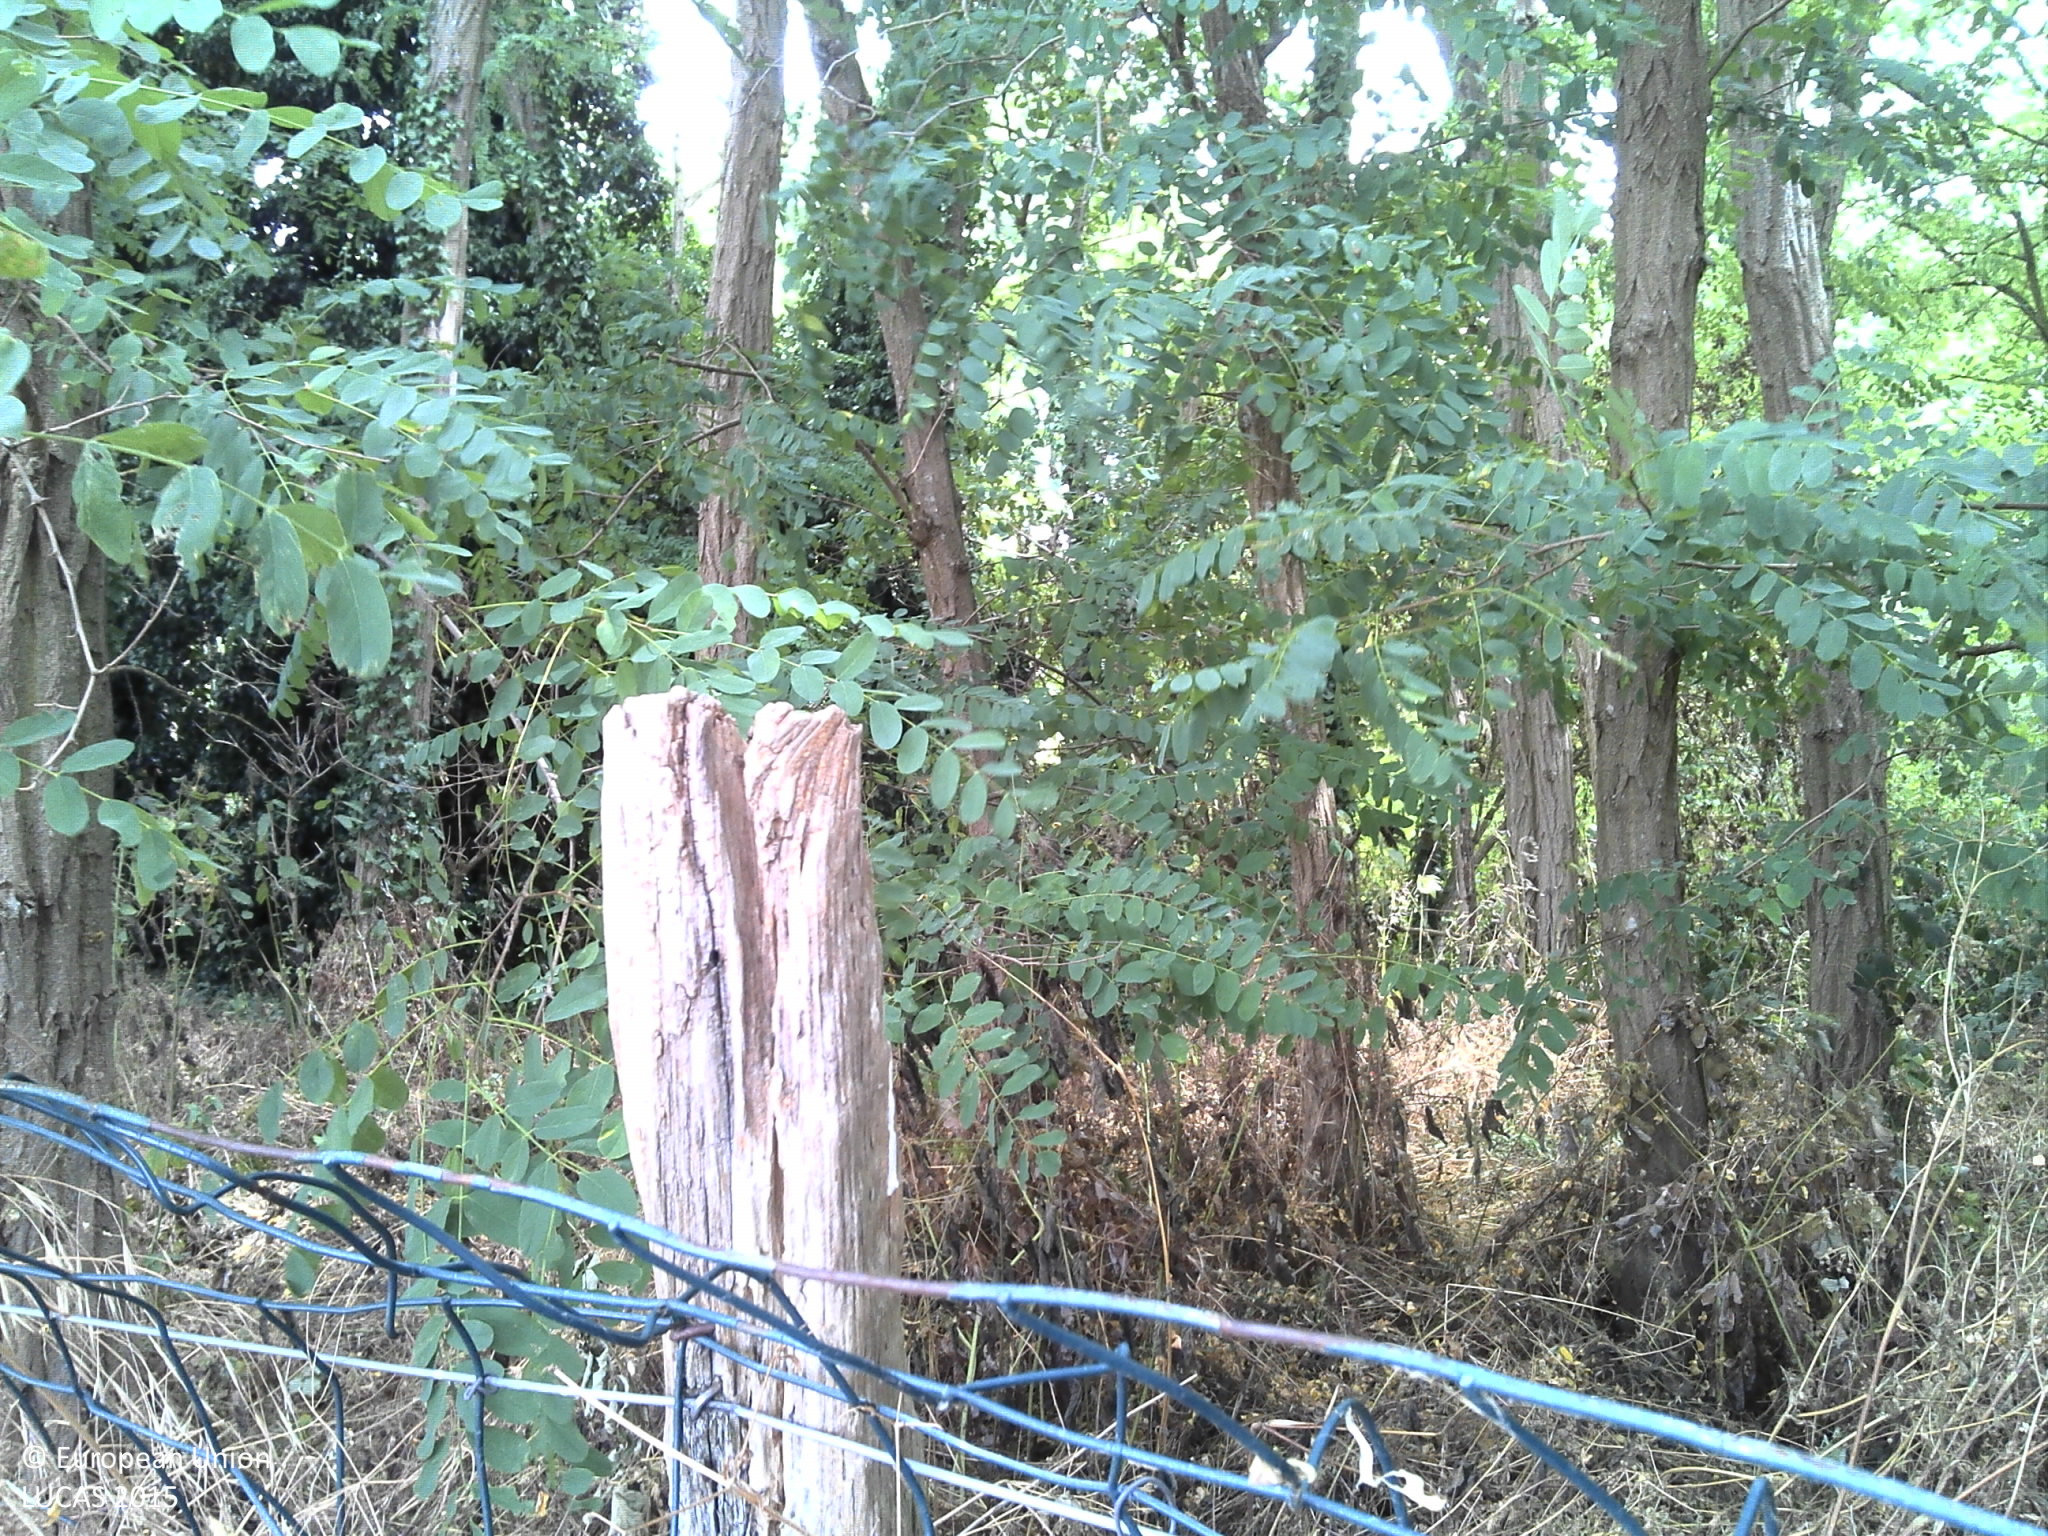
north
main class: Woodland
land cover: Broadleaved woodland
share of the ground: 25 - 50 %
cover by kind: broadleaved forest trees 80 %, herbaceous plants 20 %
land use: Agriculture (excluding fallow land and kitchen gardens)
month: July
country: FR
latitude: 48.5602
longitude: 2.4417
